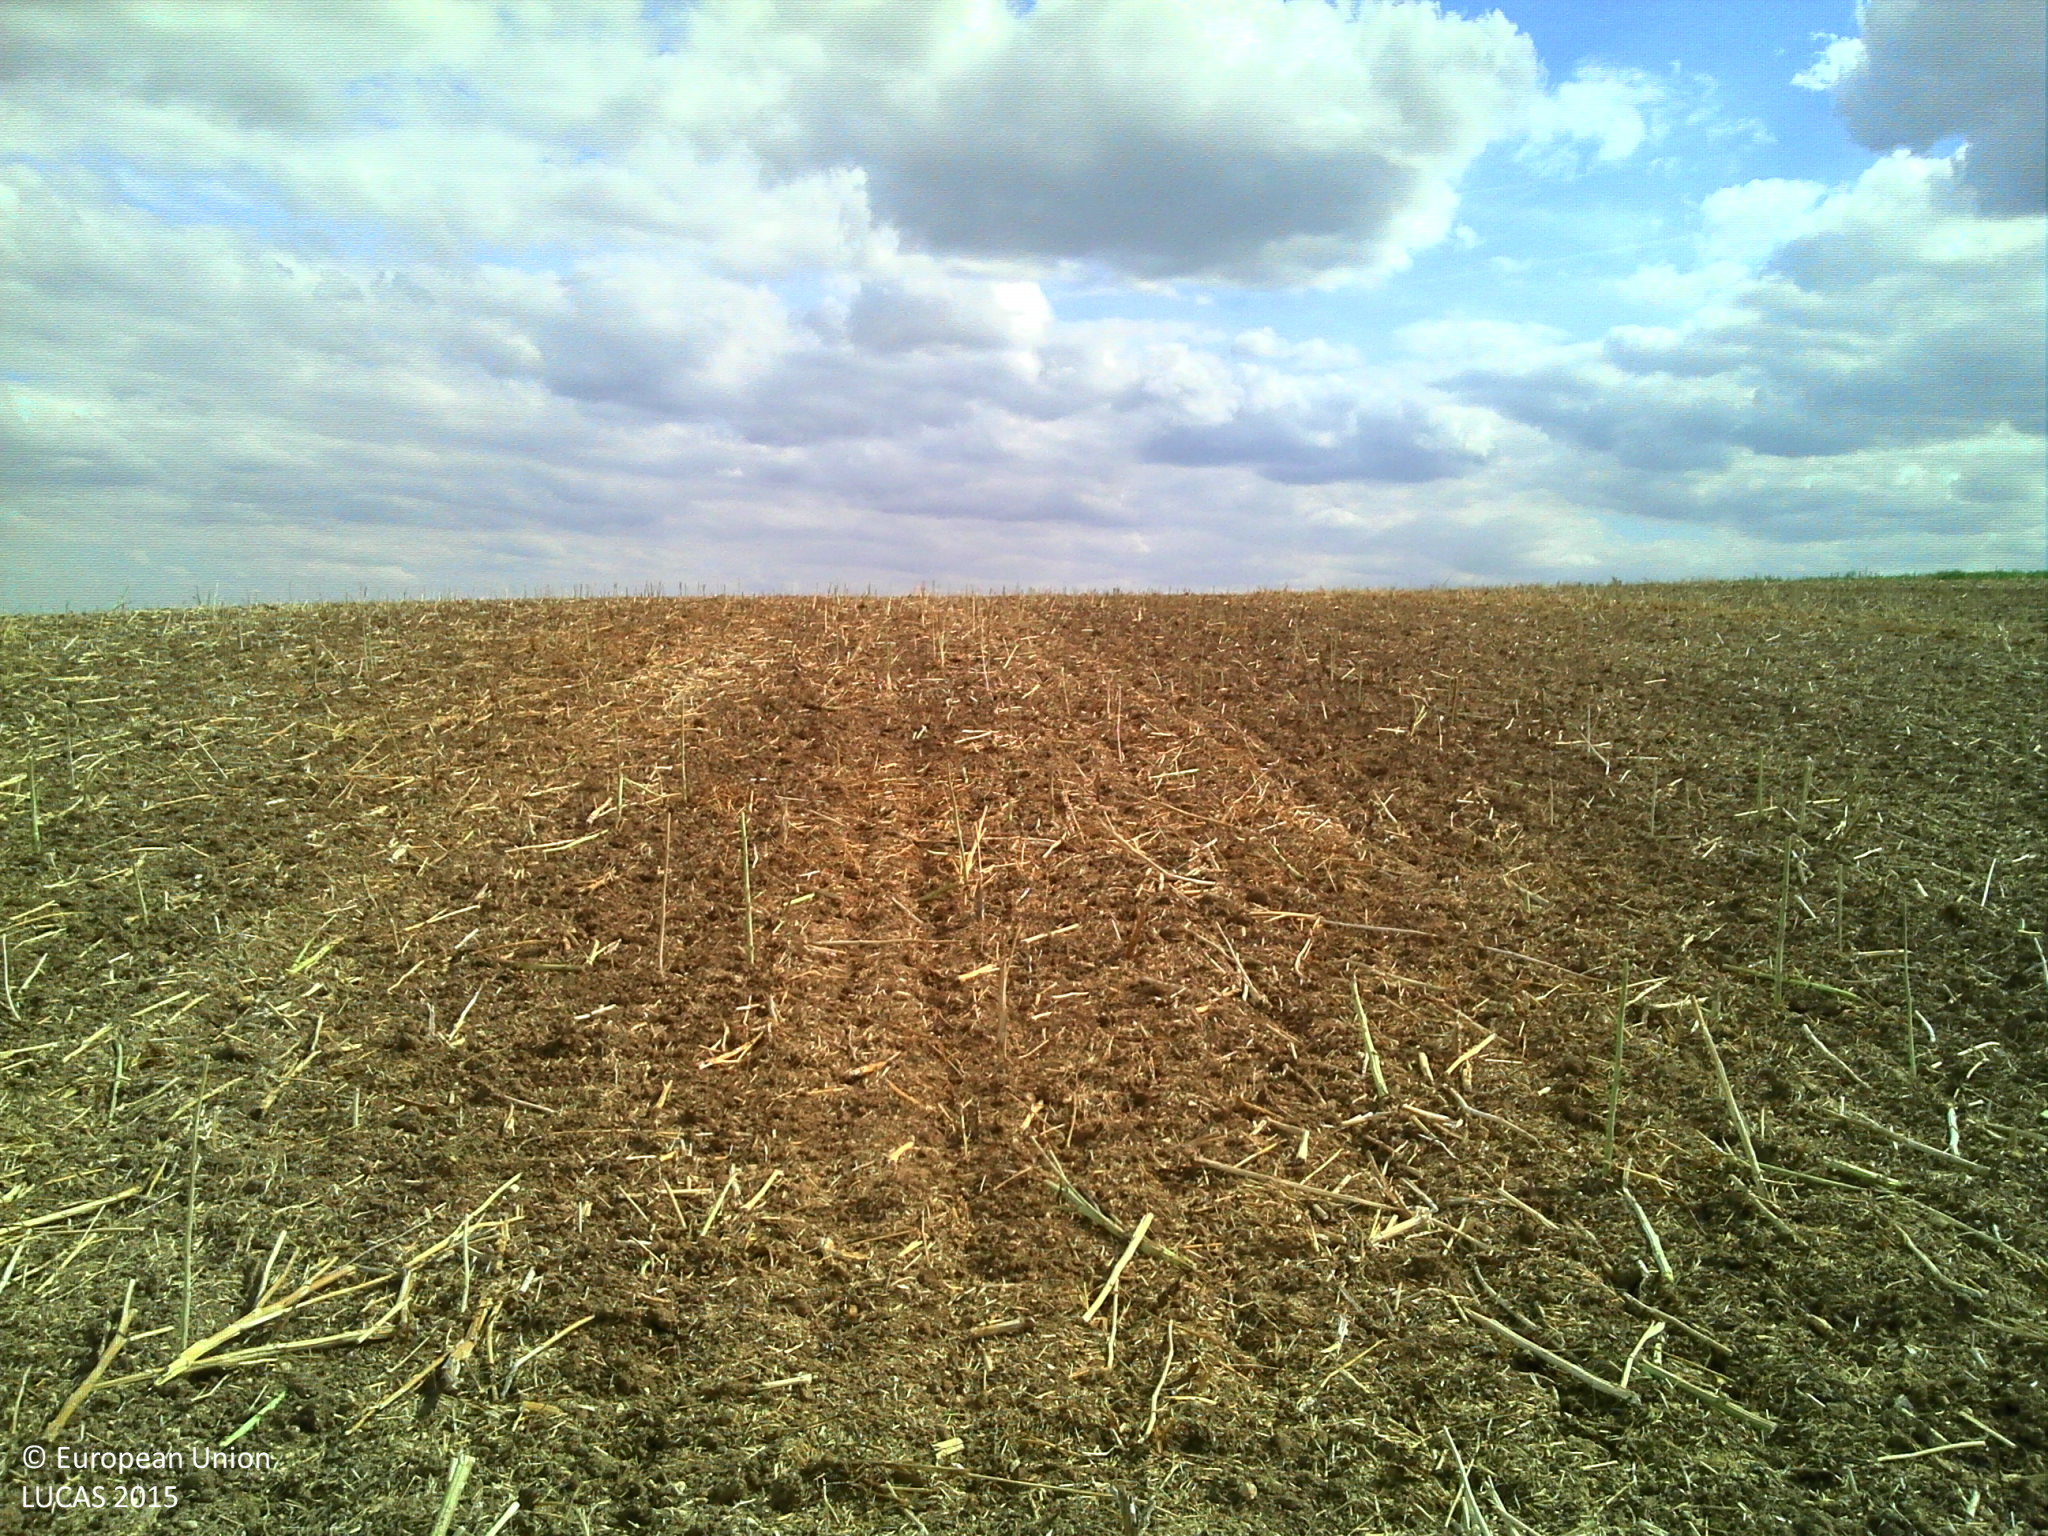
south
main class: Cropland
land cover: Rape and turnip rape
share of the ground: > 75 %
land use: Agriculture (excluding fallow land and kitchen gardens)
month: July
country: FR
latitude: 49.2604
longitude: 4.1831
